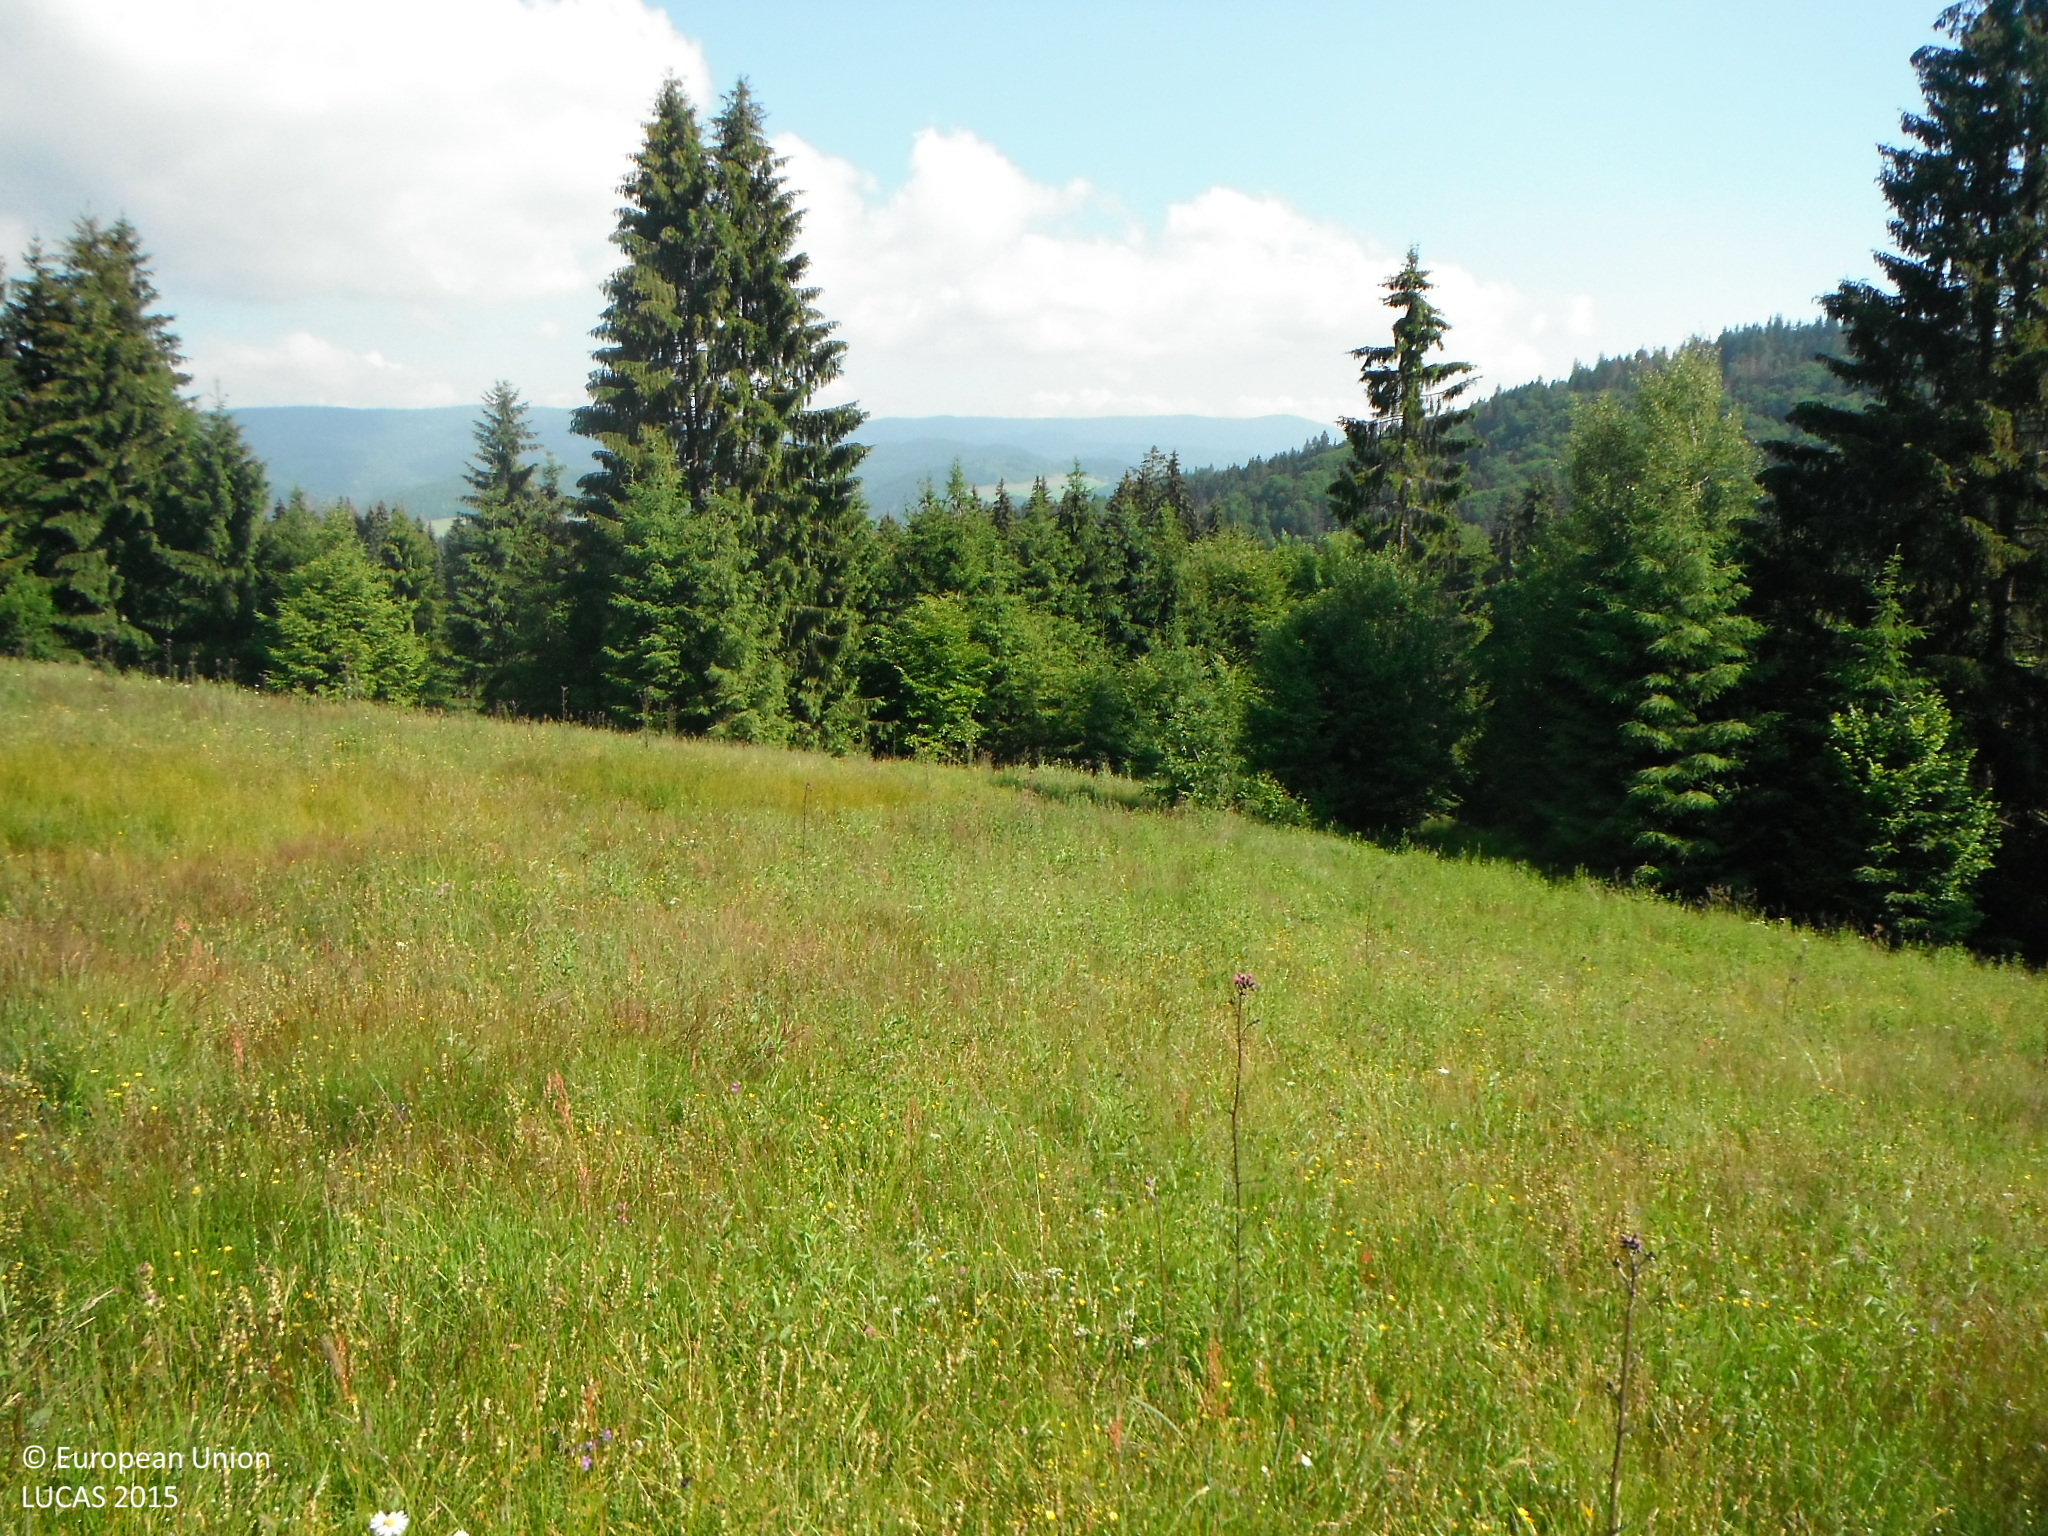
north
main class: Grassland
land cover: Grassland without tree/shrub cover
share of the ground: > 75 %
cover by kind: herbaceous plants 100 %
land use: Semi-natural and natural areas not in use
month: June
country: SK
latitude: 49.2311
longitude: 19.4325
